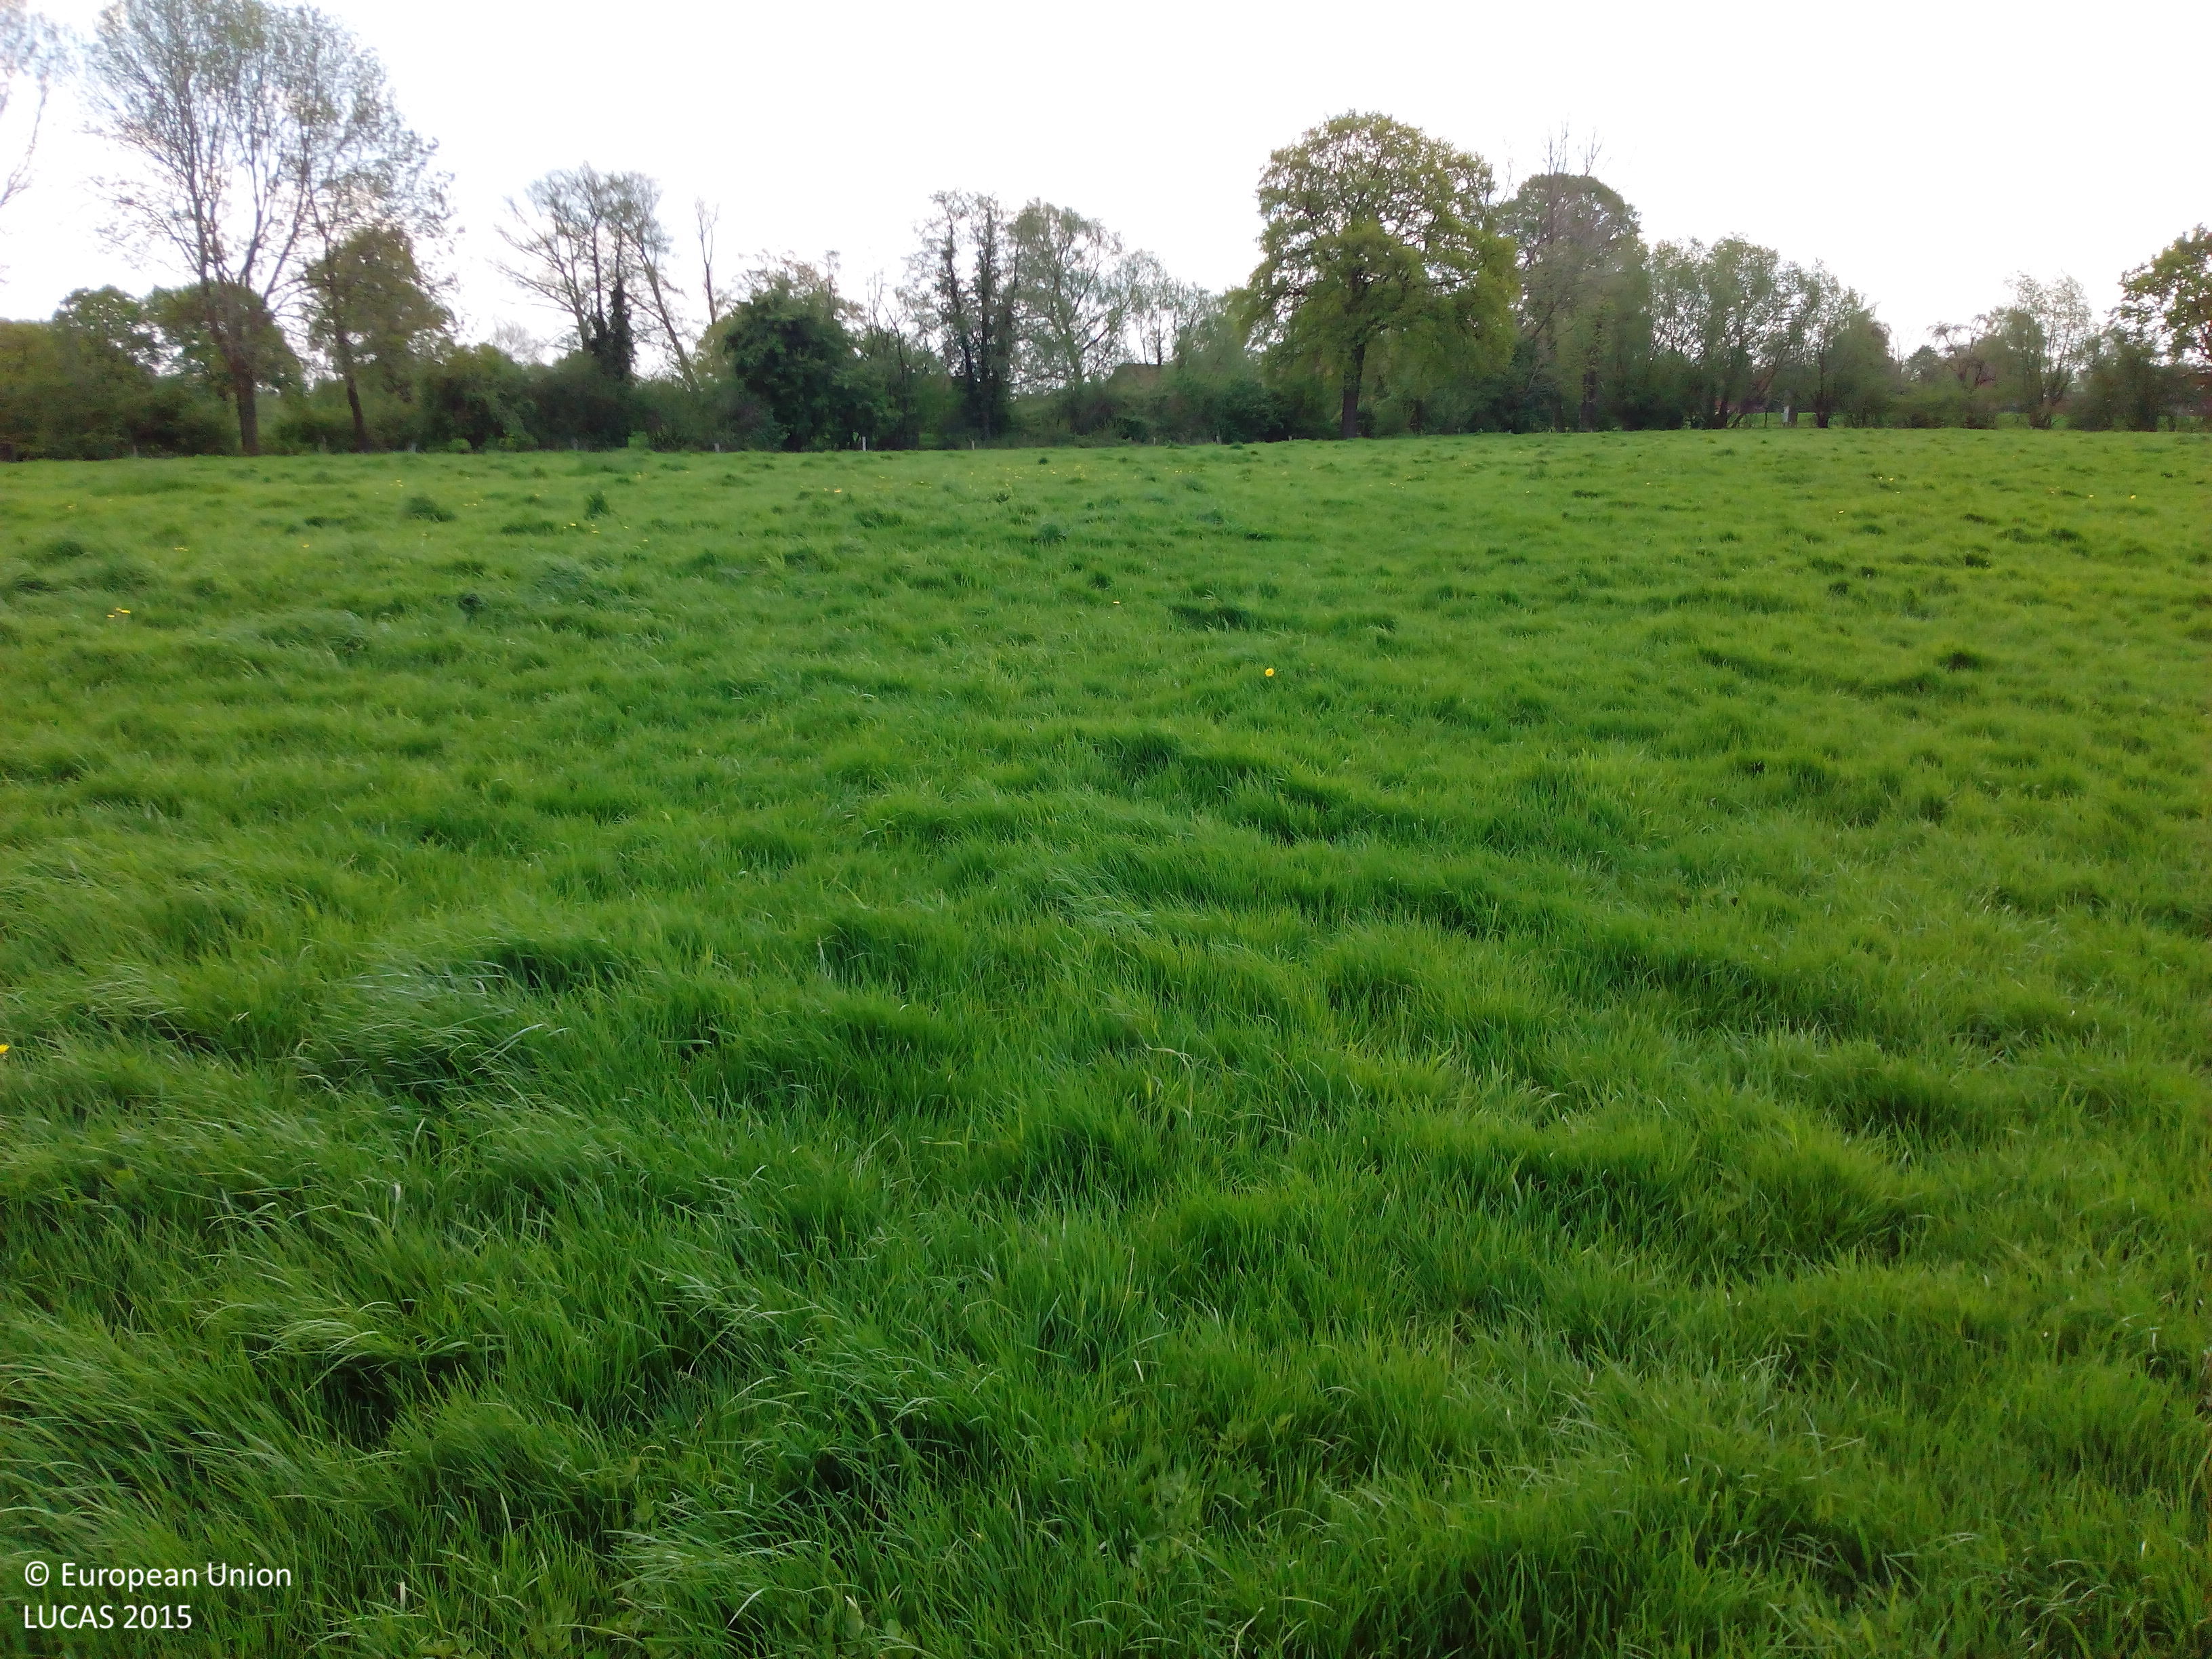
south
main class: Grassland
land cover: Grassland without tree/shrub cover
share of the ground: > 75 %
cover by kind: herbaceous plants 100 %
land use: Agriculture (excluding fallow land and kitchen gardens)
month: May
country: DE
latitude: 52.0264
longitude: 7.4498
